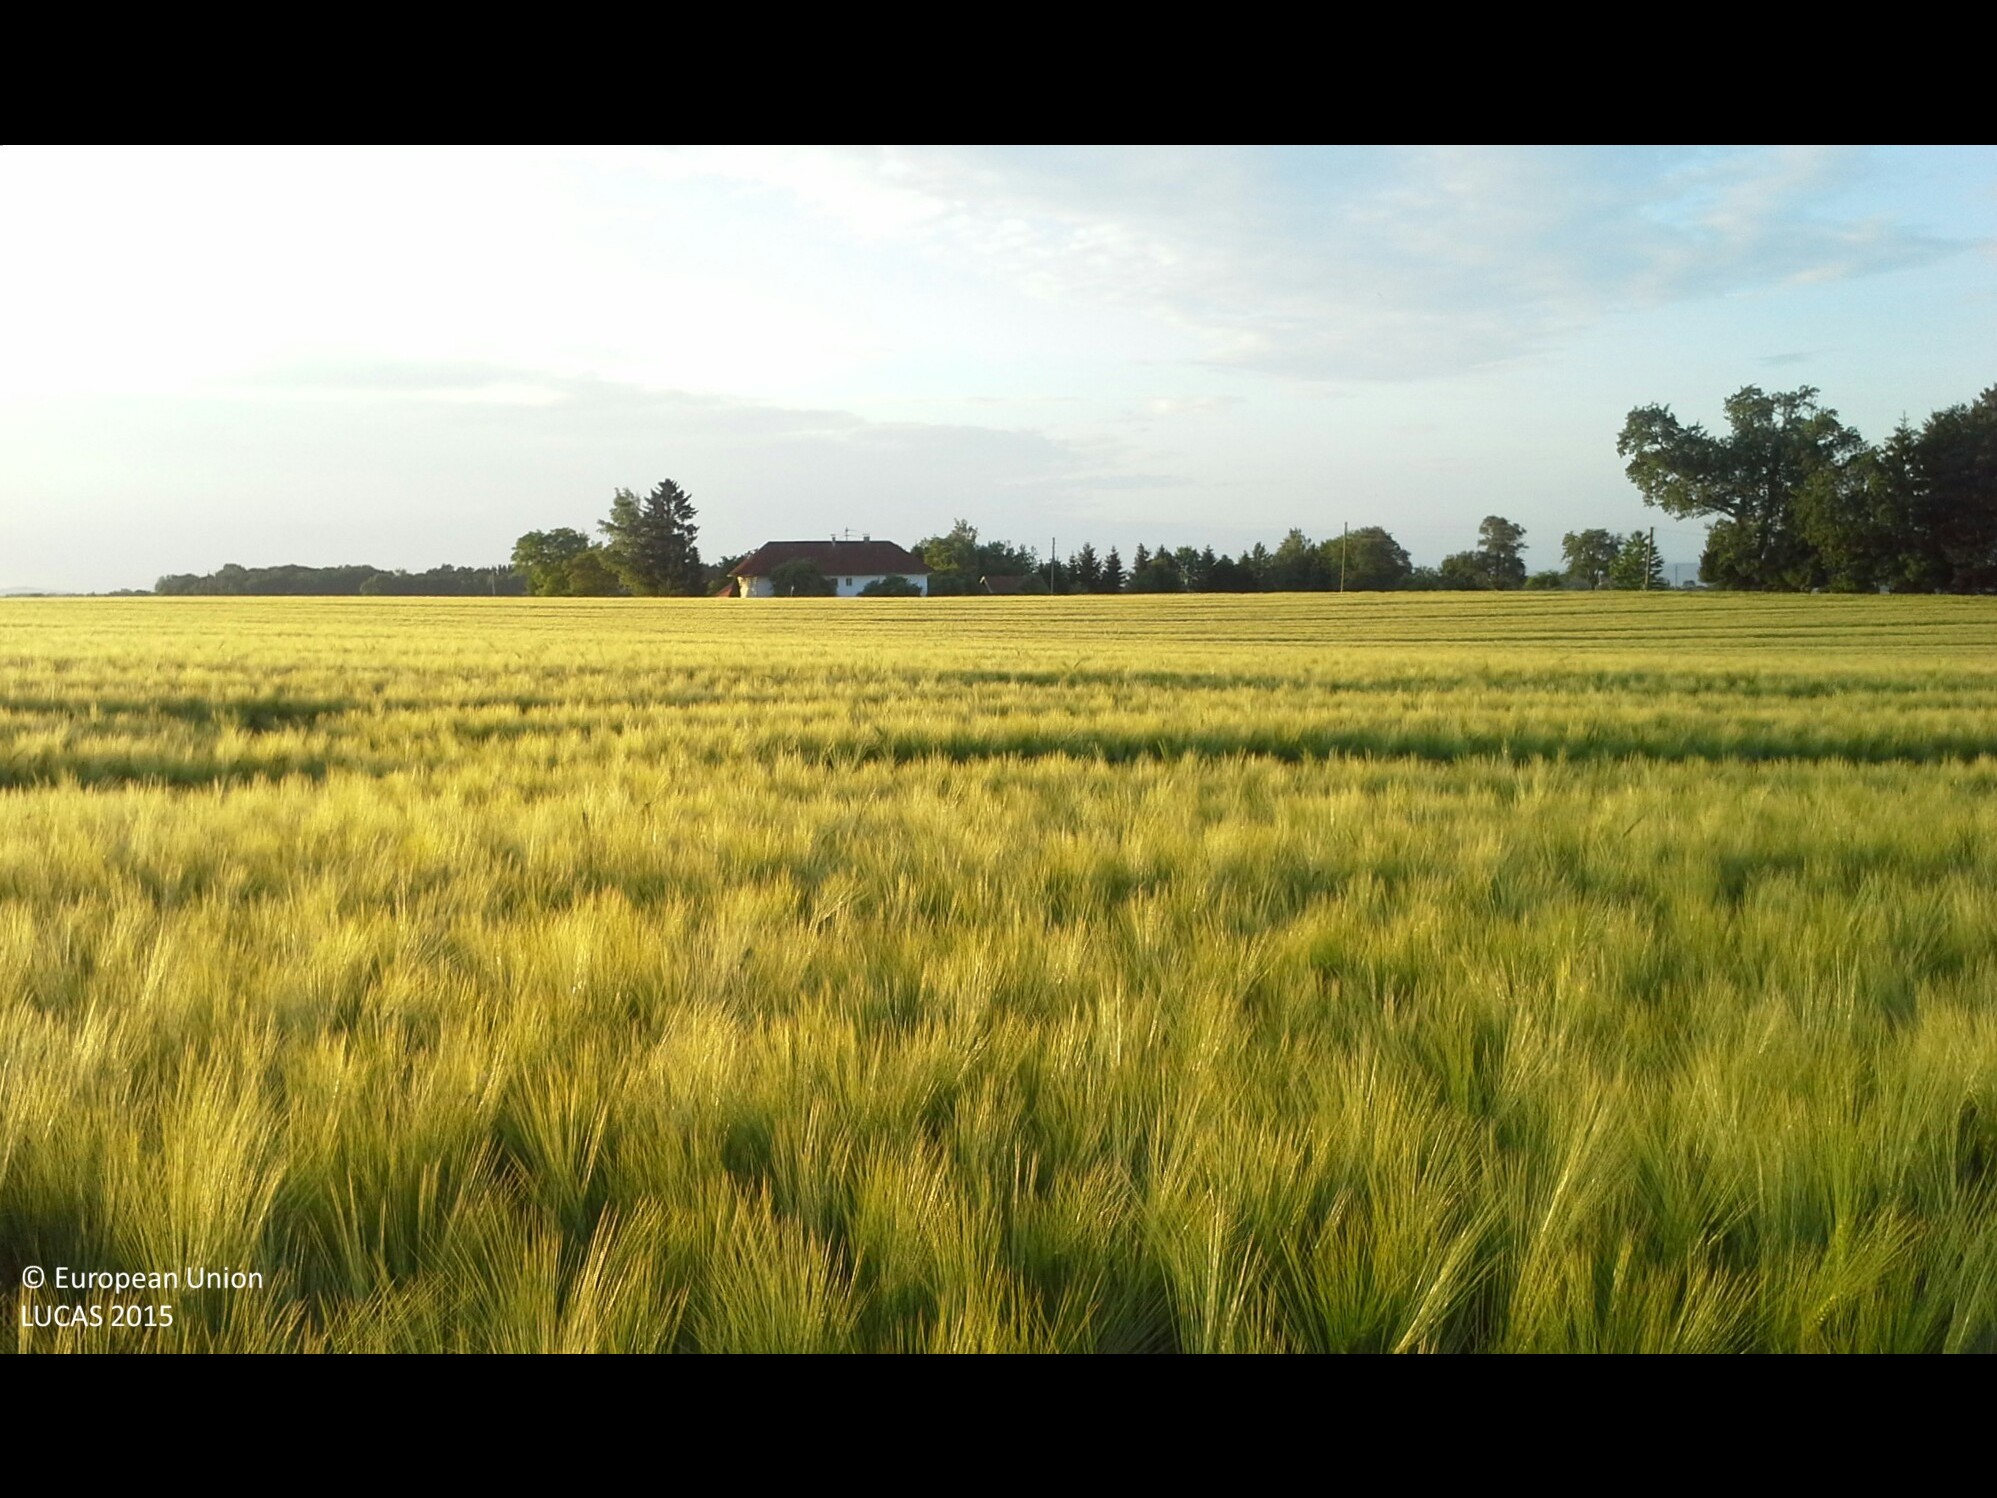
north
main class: Cropland
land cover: Barley
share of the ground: > 75 %
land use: Agriculture (excluding fallow land and kitchen gardens)
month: May
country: AT
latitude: 48.1392
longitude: 14.3138
